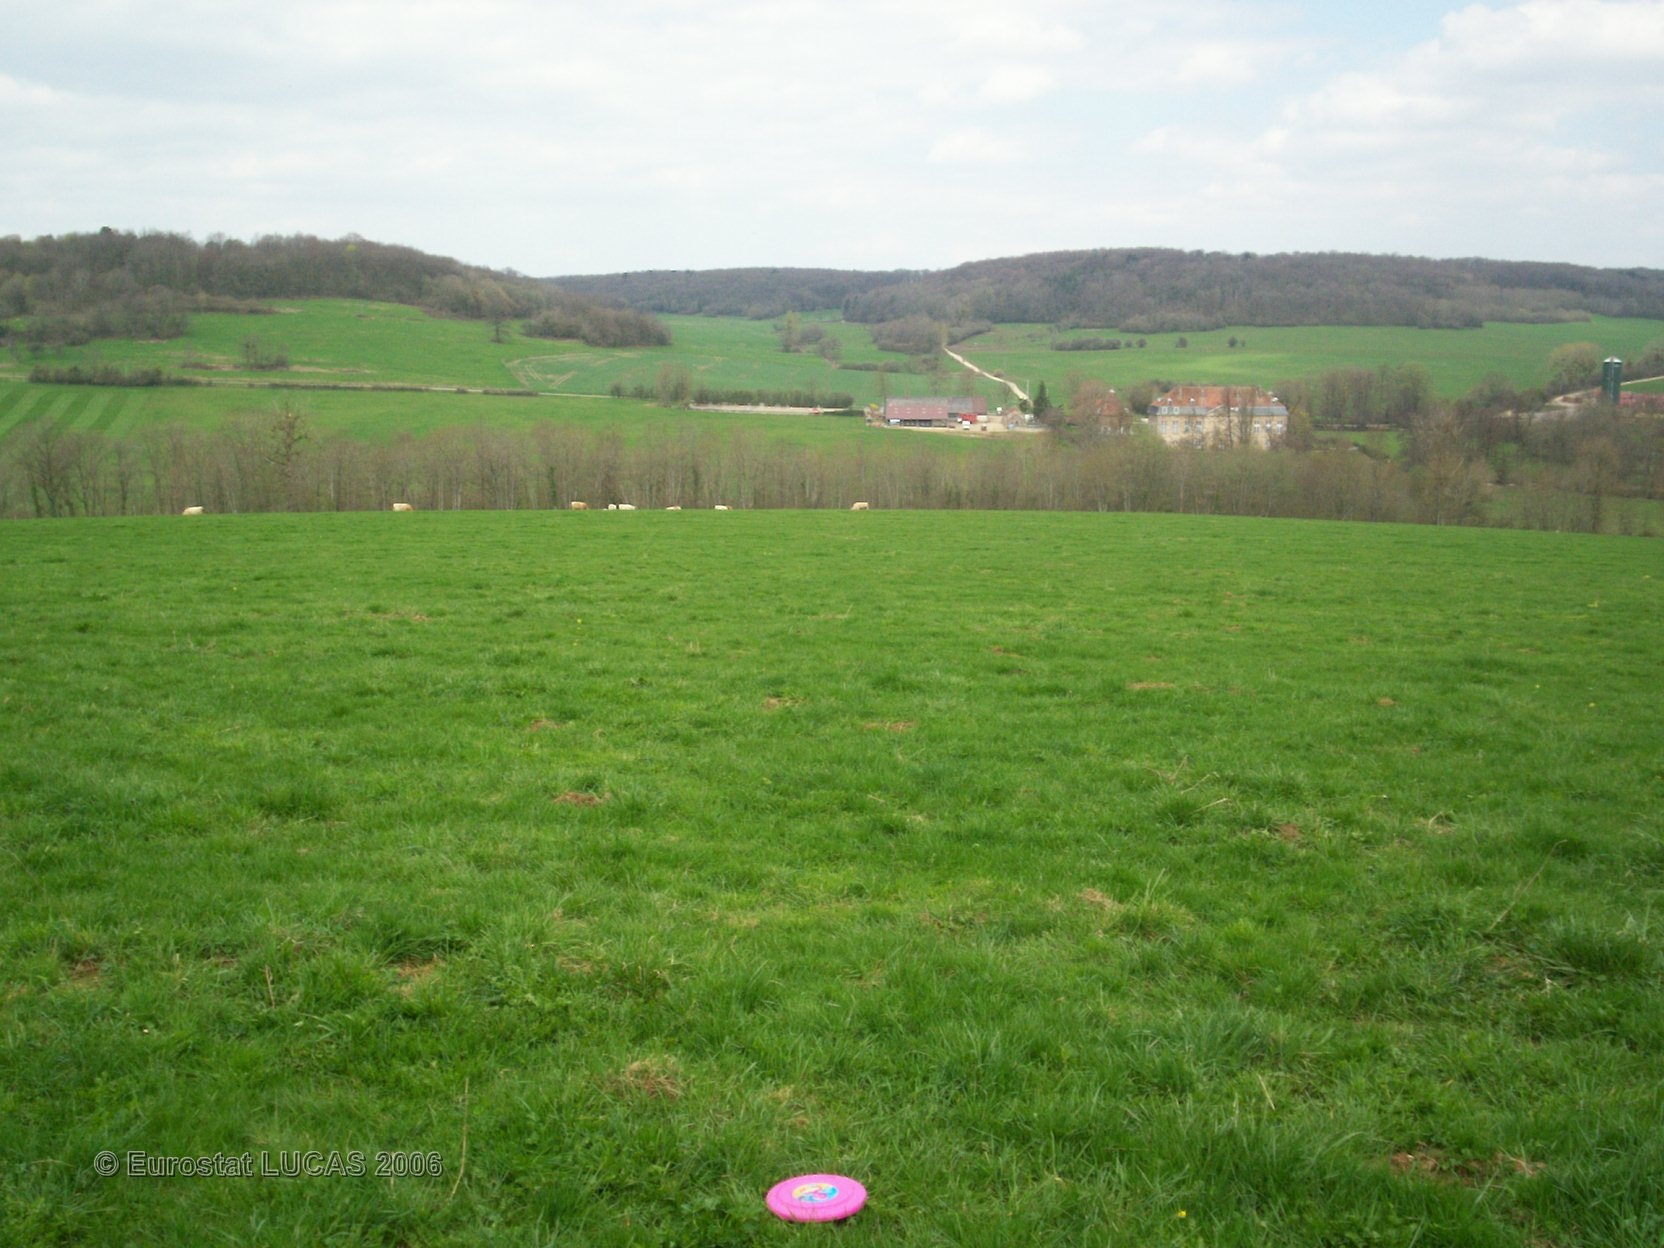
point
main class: Grassland
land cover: Grassland without tree/shrub cover
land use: Agriculture (excluding fallow land and kitchen gardens)
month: April
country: FR
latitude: 47.8881
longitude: 5.2789
